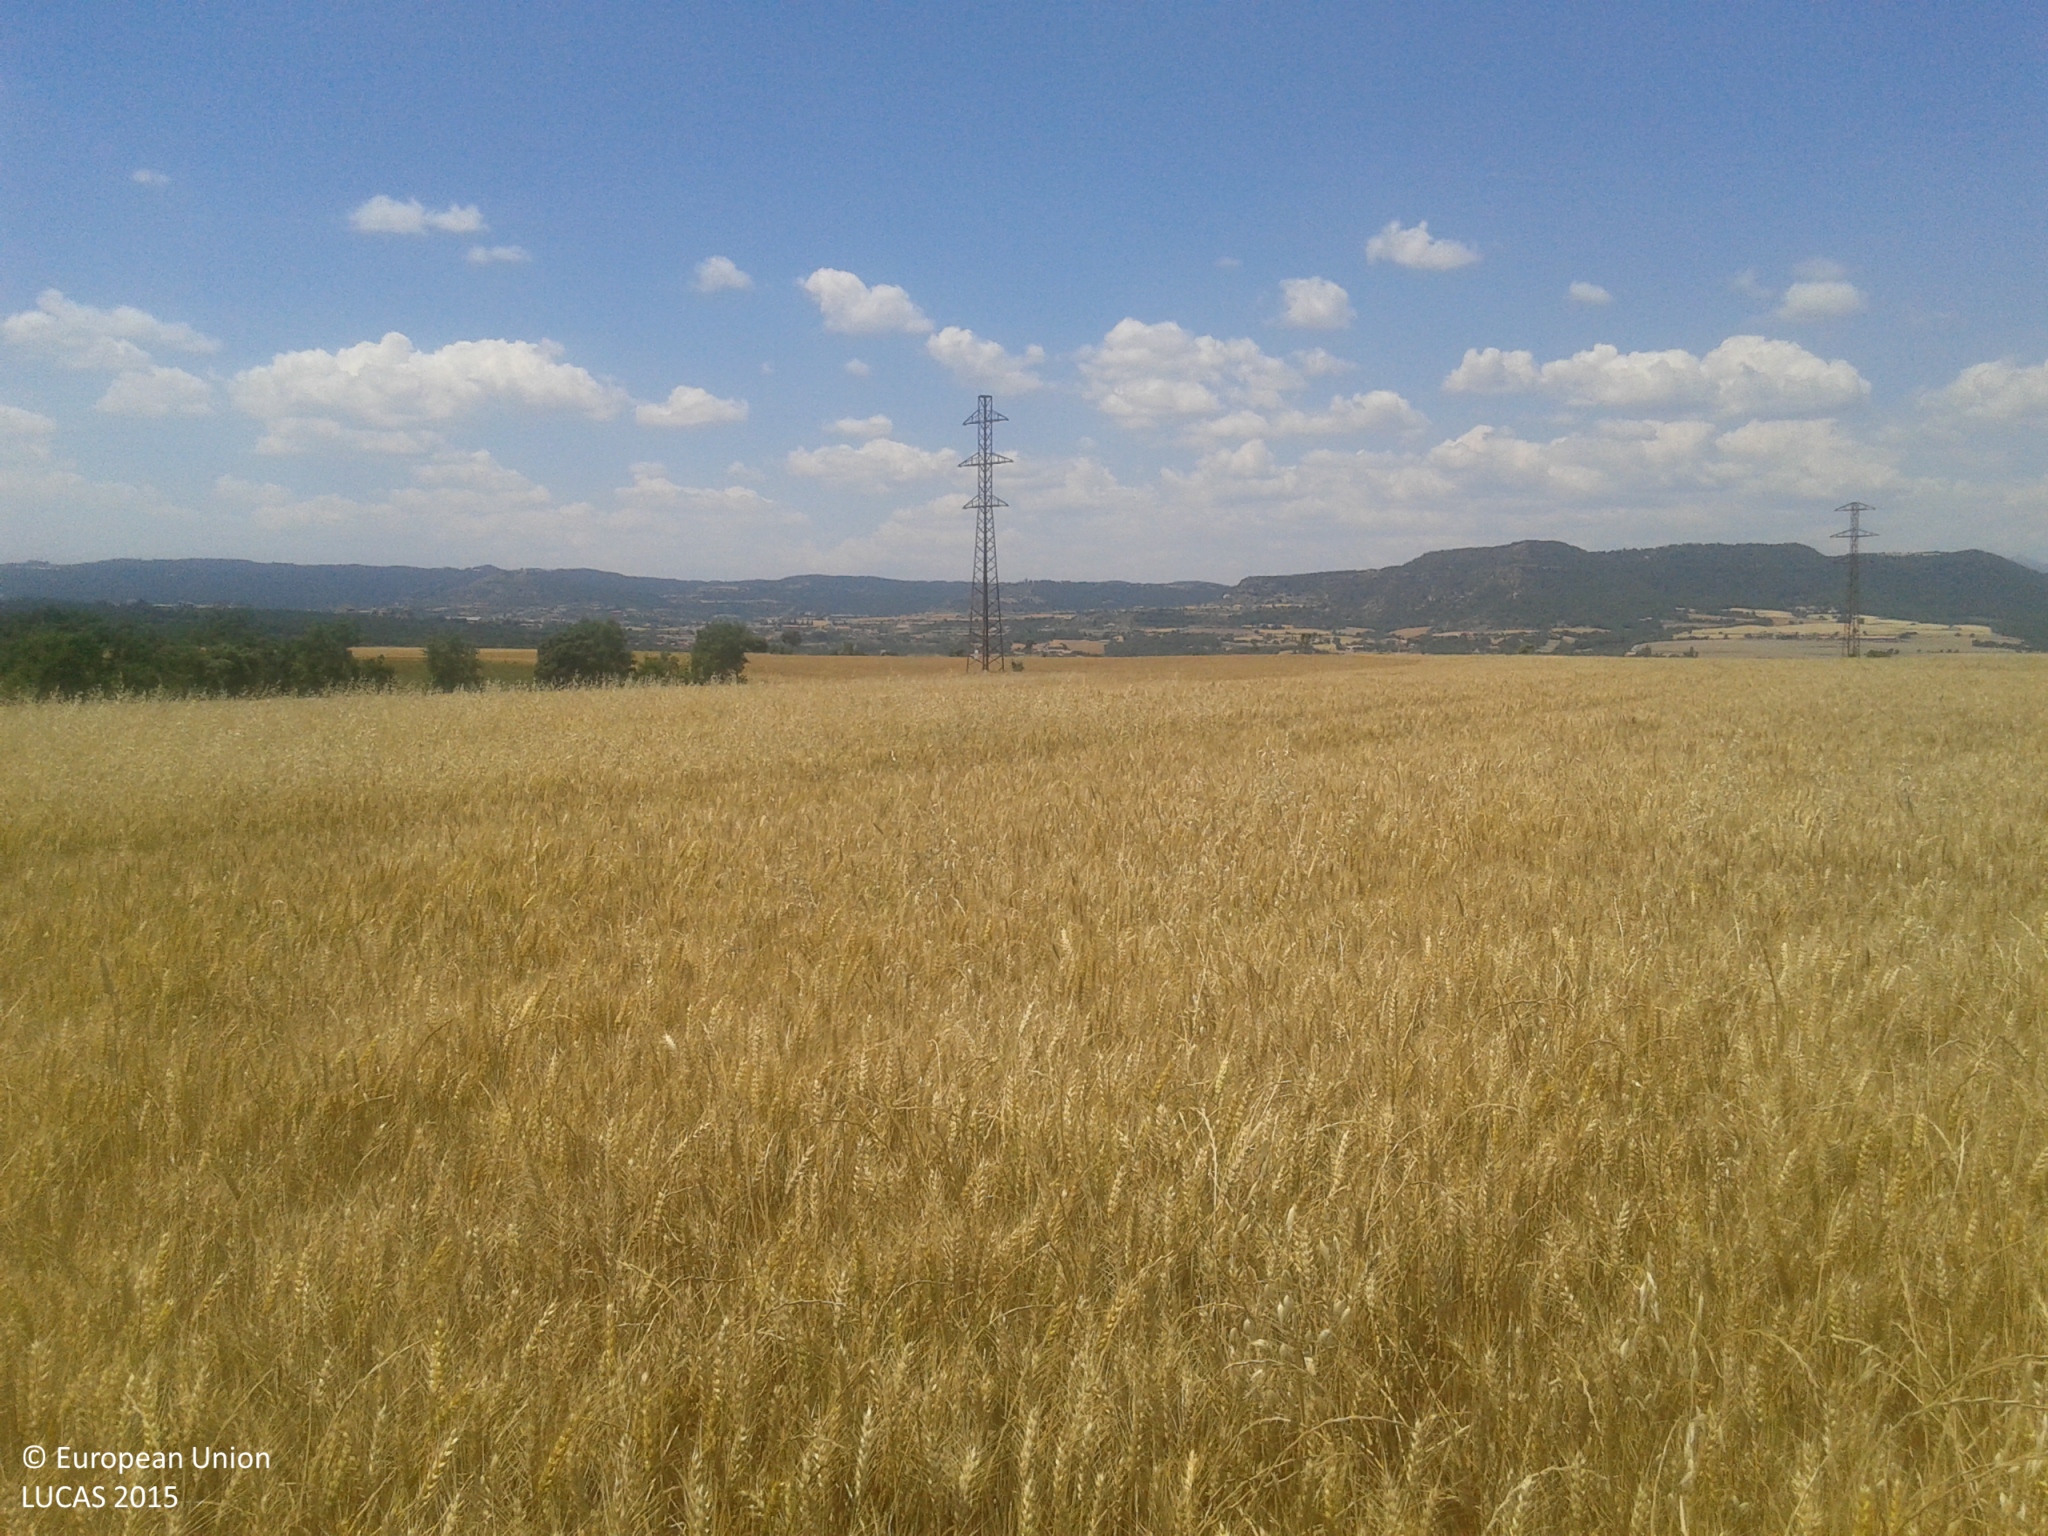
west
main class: Cropland
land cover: Common wheat
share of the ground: > 75 %
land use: Agriculture (excluding fallow land and kitchen gardens)
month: June
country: ES
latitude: 41.9939
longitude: 1.5747
